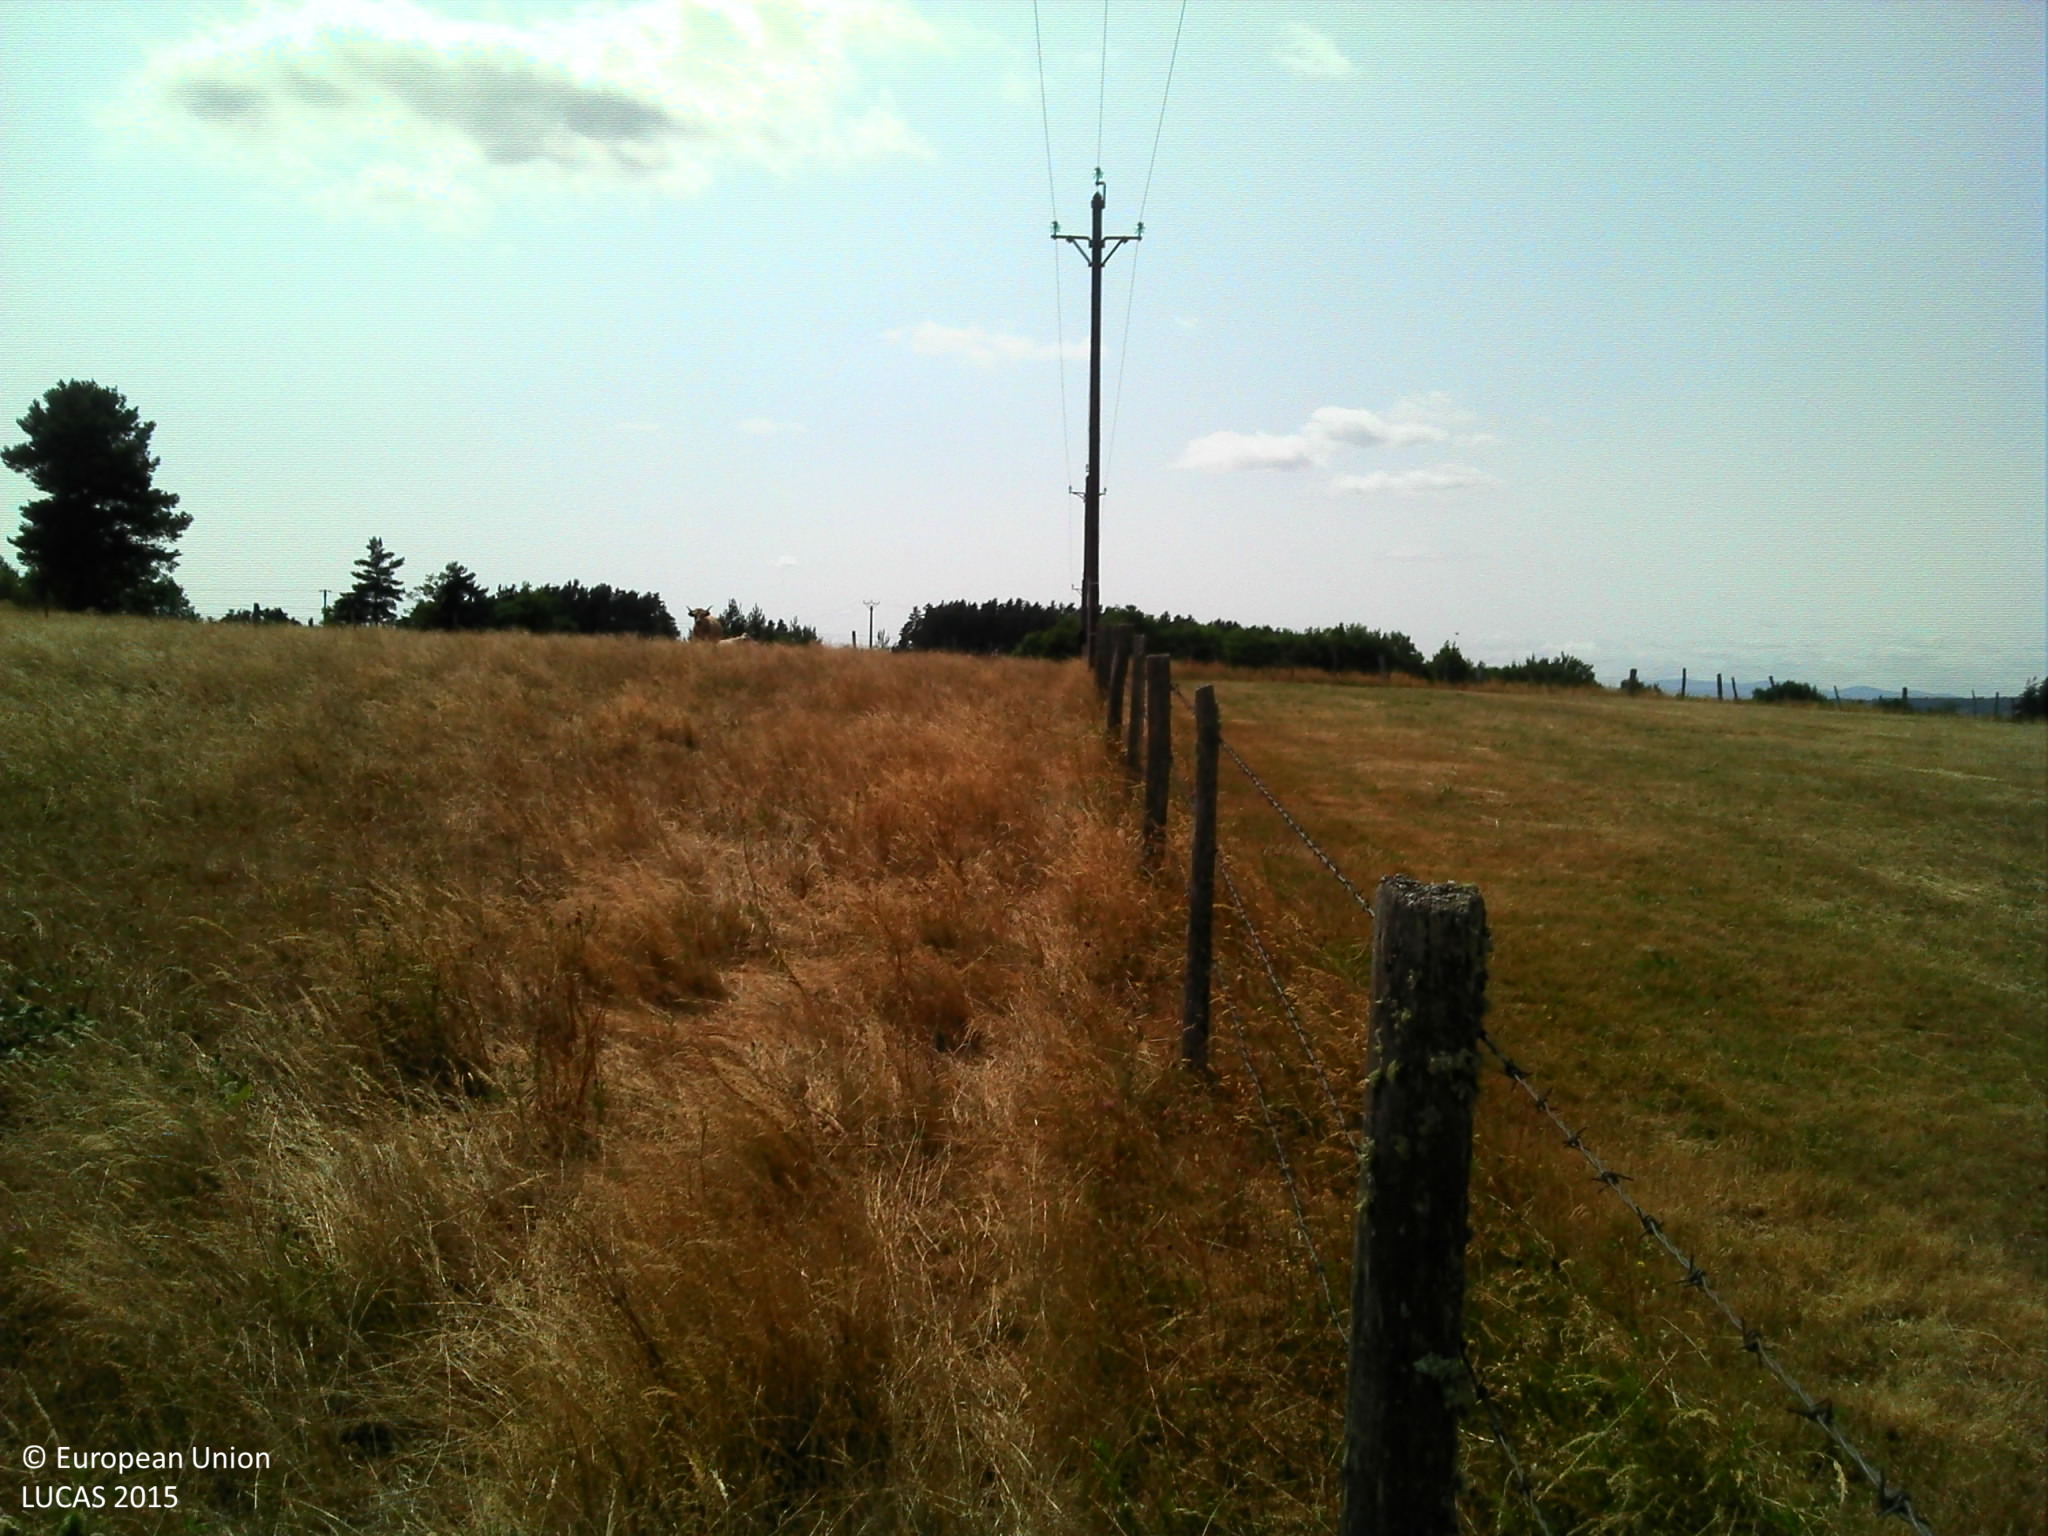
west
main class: Grassland
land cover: Grassland without tree/shrub cover
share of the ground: > 75 %
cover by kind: herbaceous plants 100 %
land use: Agriculture (excluding fallow land and kitchen gardens)
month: July
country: FR
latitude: 44.9592
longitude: 3.1954
